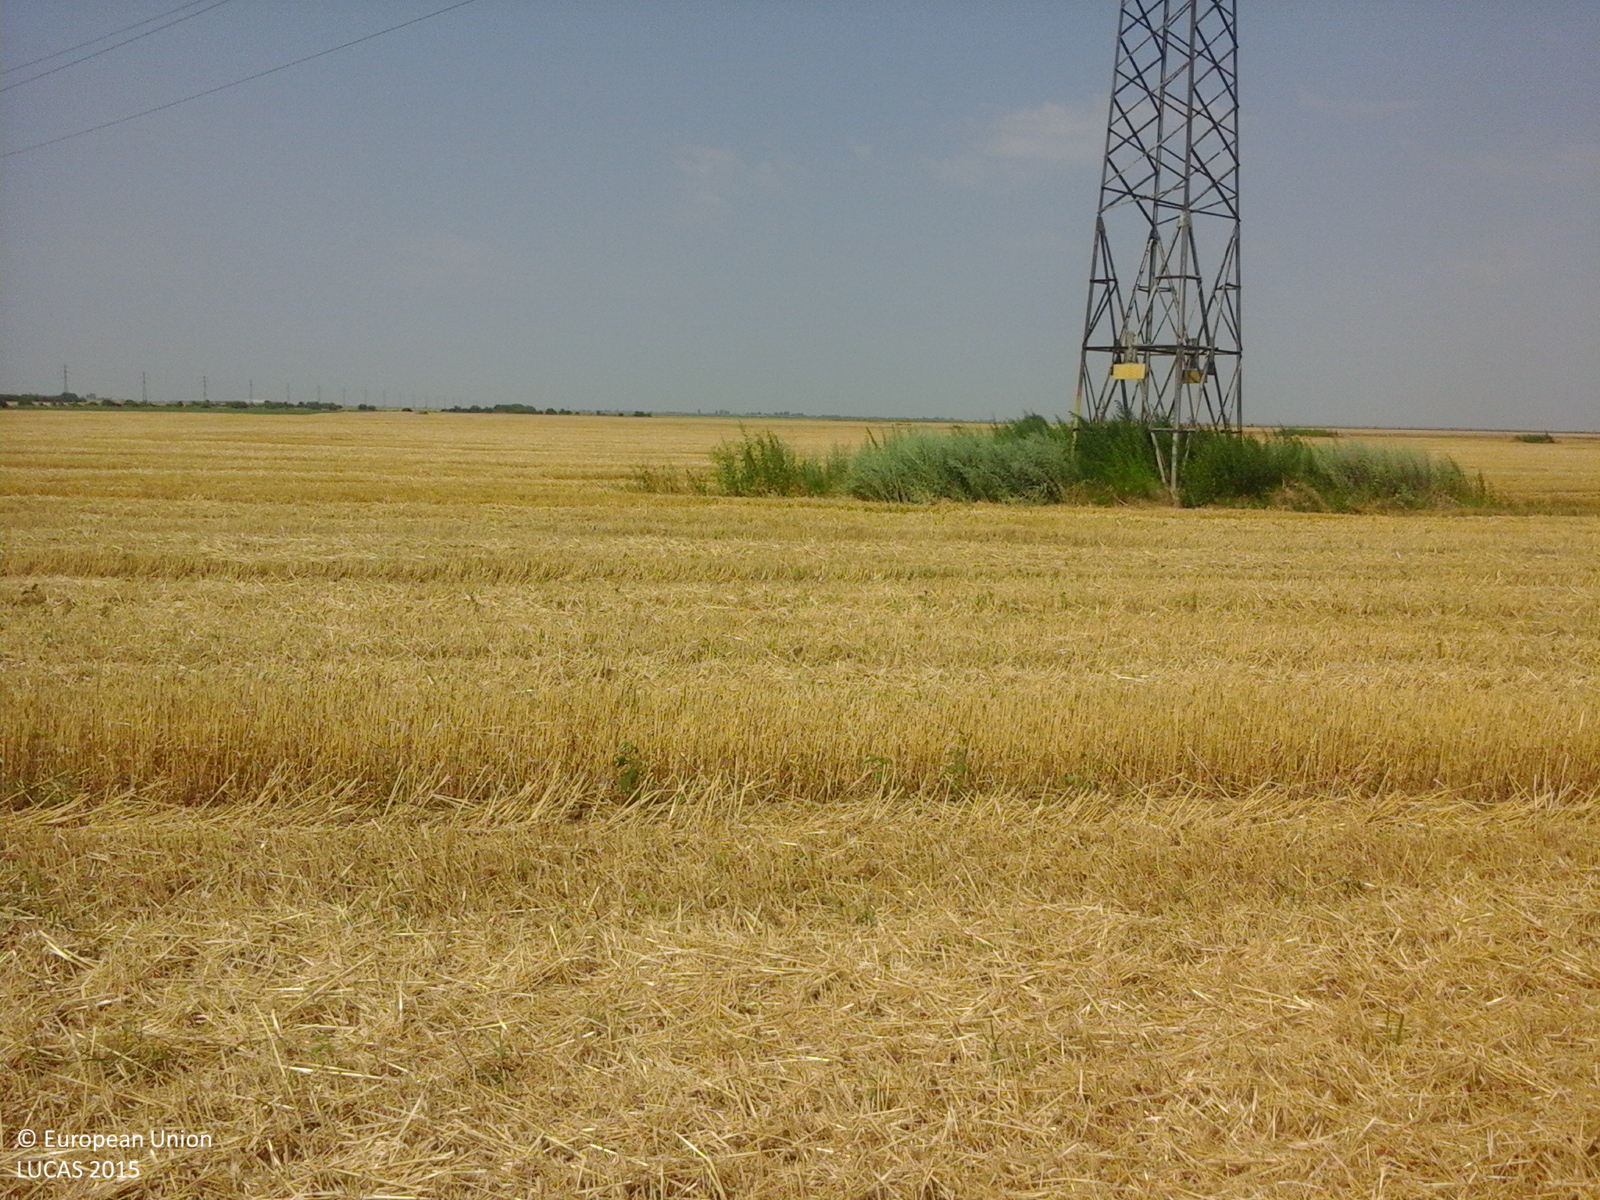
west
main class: Cropland
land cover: Maize
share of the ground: > 75 %
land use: Agriculture (excluding fallow land and kitchen gardens)
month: July
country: RO
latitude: 44.6271
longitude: 27.5525
